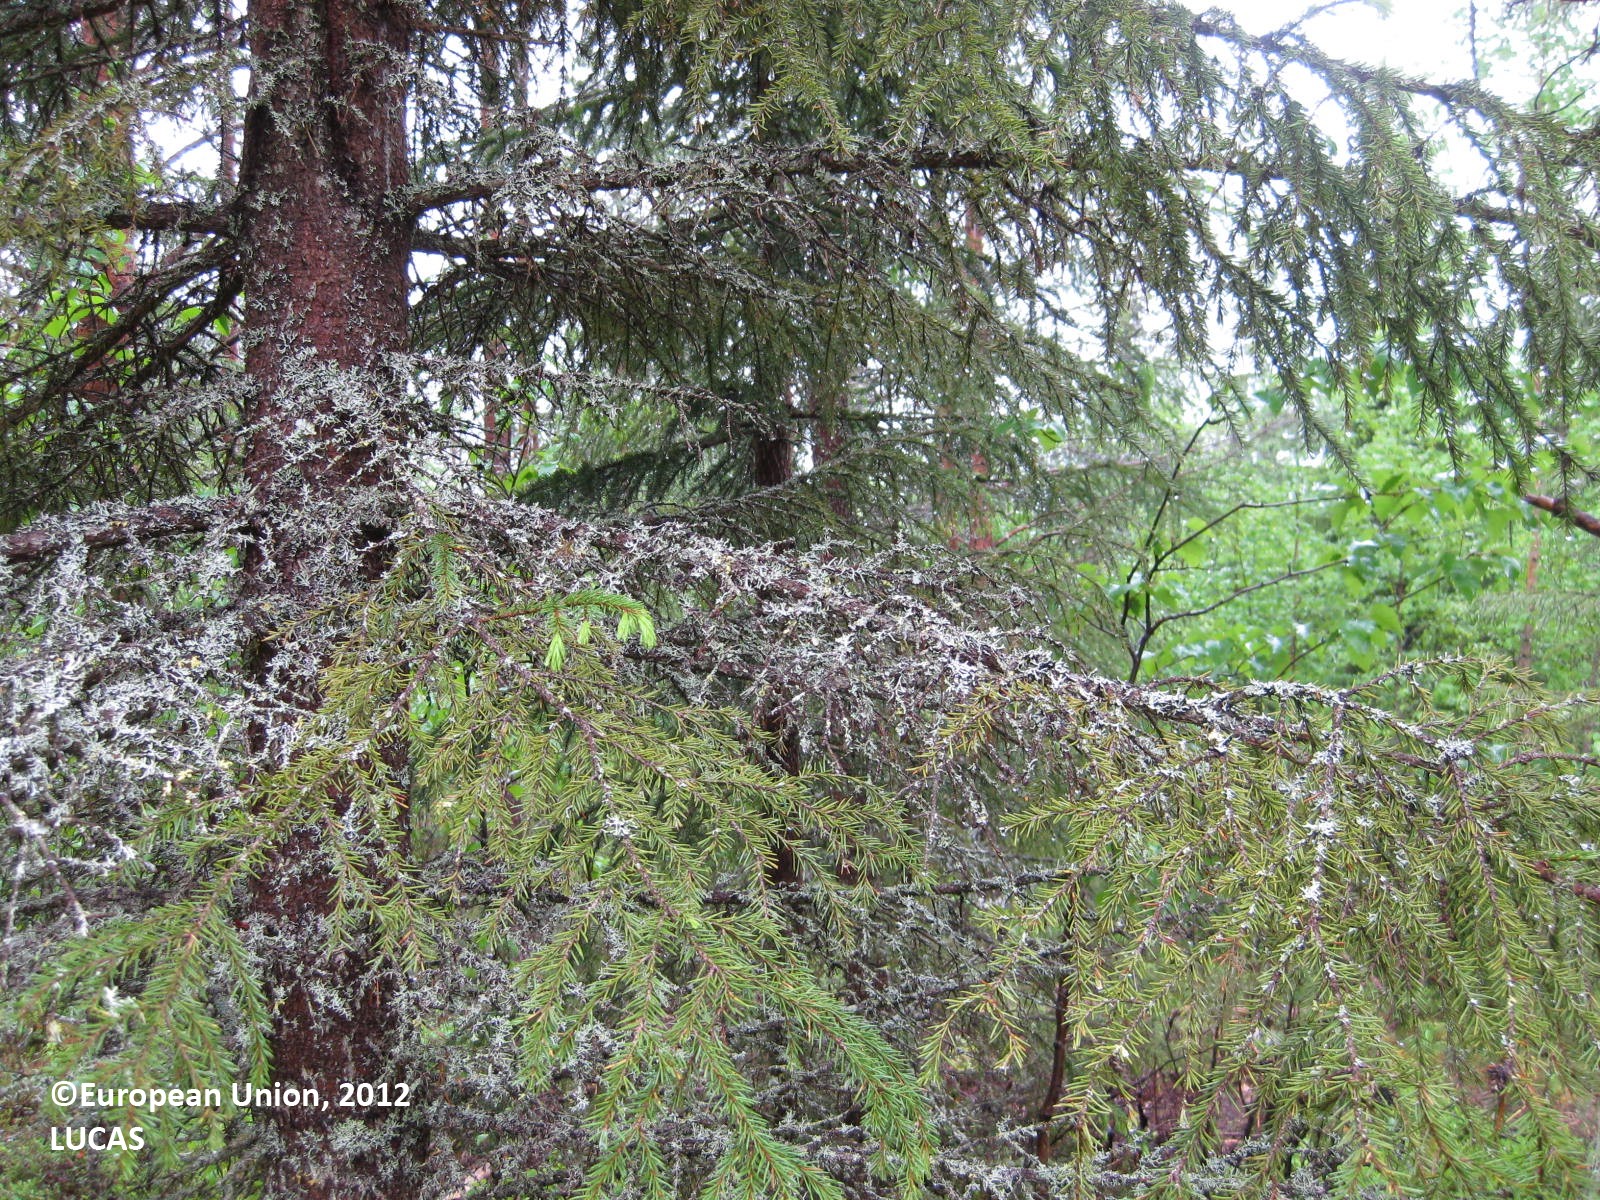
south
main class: Woodland
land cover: Other coniferous woodland
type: boreal forest
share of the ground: > 75 %
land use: Forestry
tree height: > 5 m
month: June
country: FI
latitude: 65.1501
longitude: 28.9278
